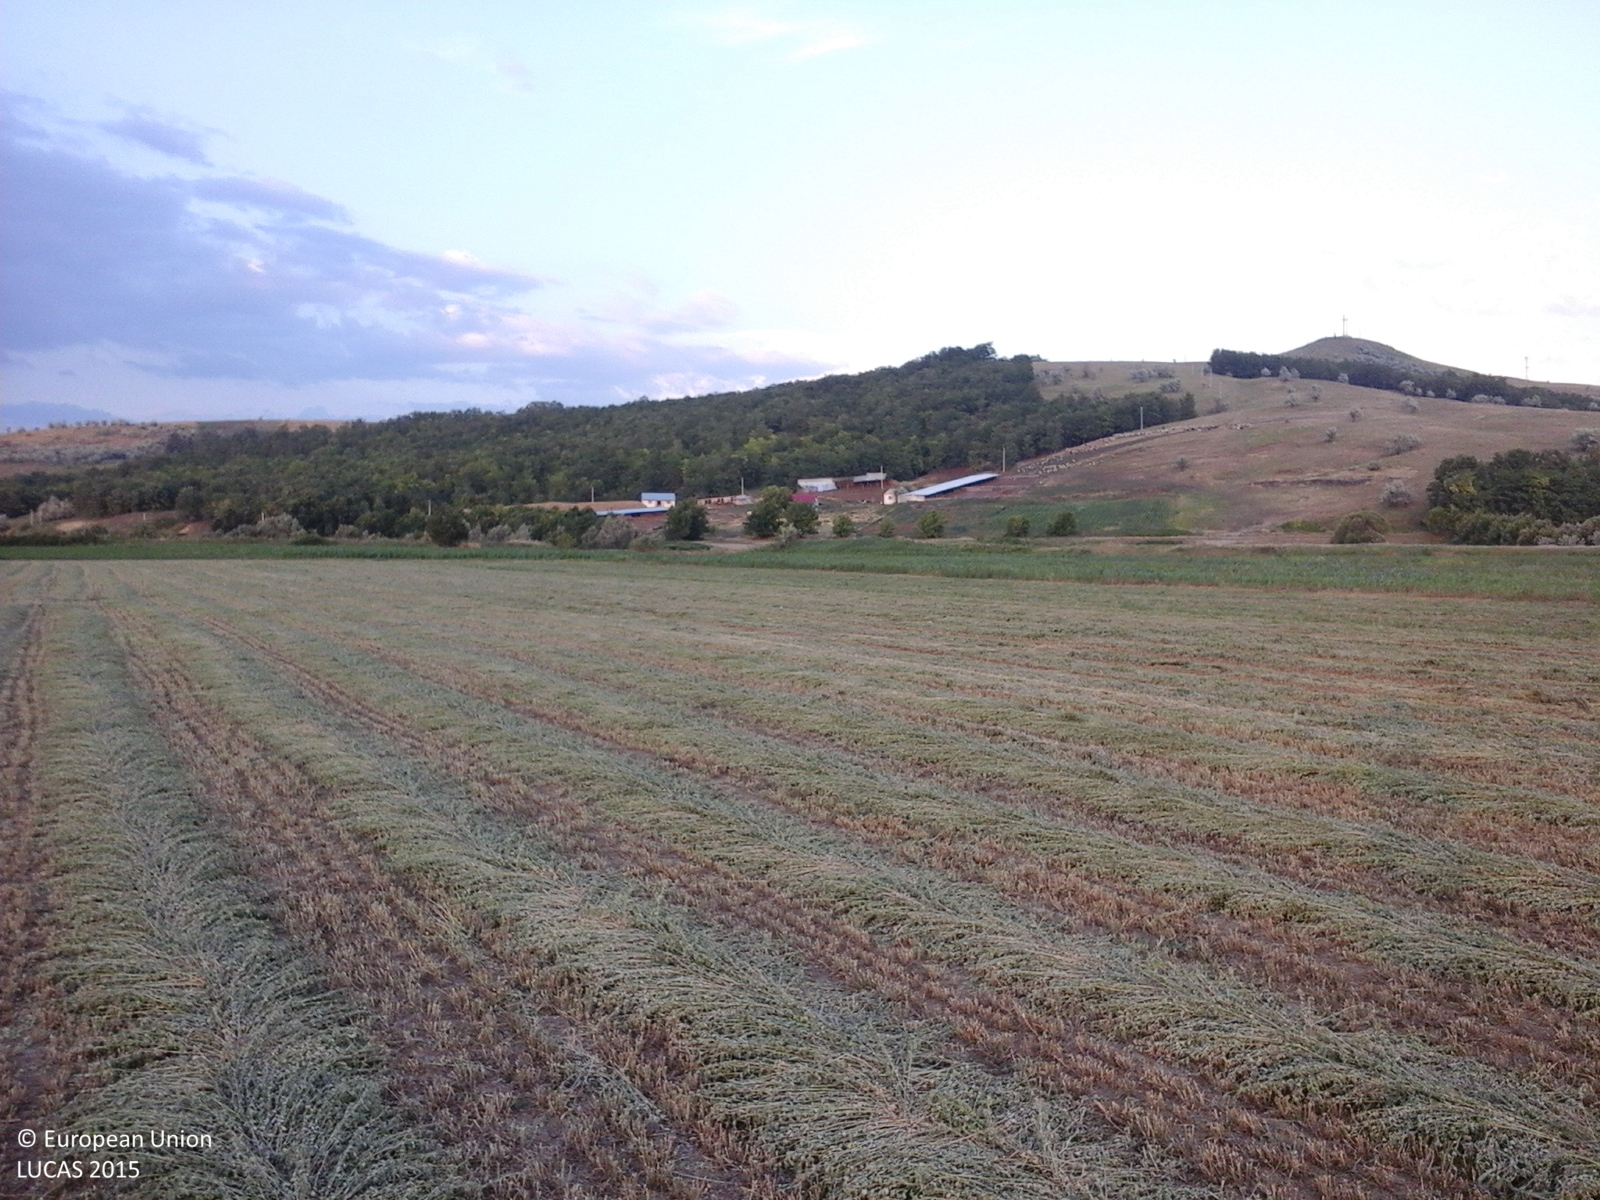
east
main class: Cropland
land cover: Lucerne
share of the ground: 25 - 50 %
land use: Agriculture (excluding fallow land and kitchen gardens)
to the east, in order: Lucerne; Tracks; Maize
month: June
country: RO
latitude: 46.8530
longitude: 27.7888
